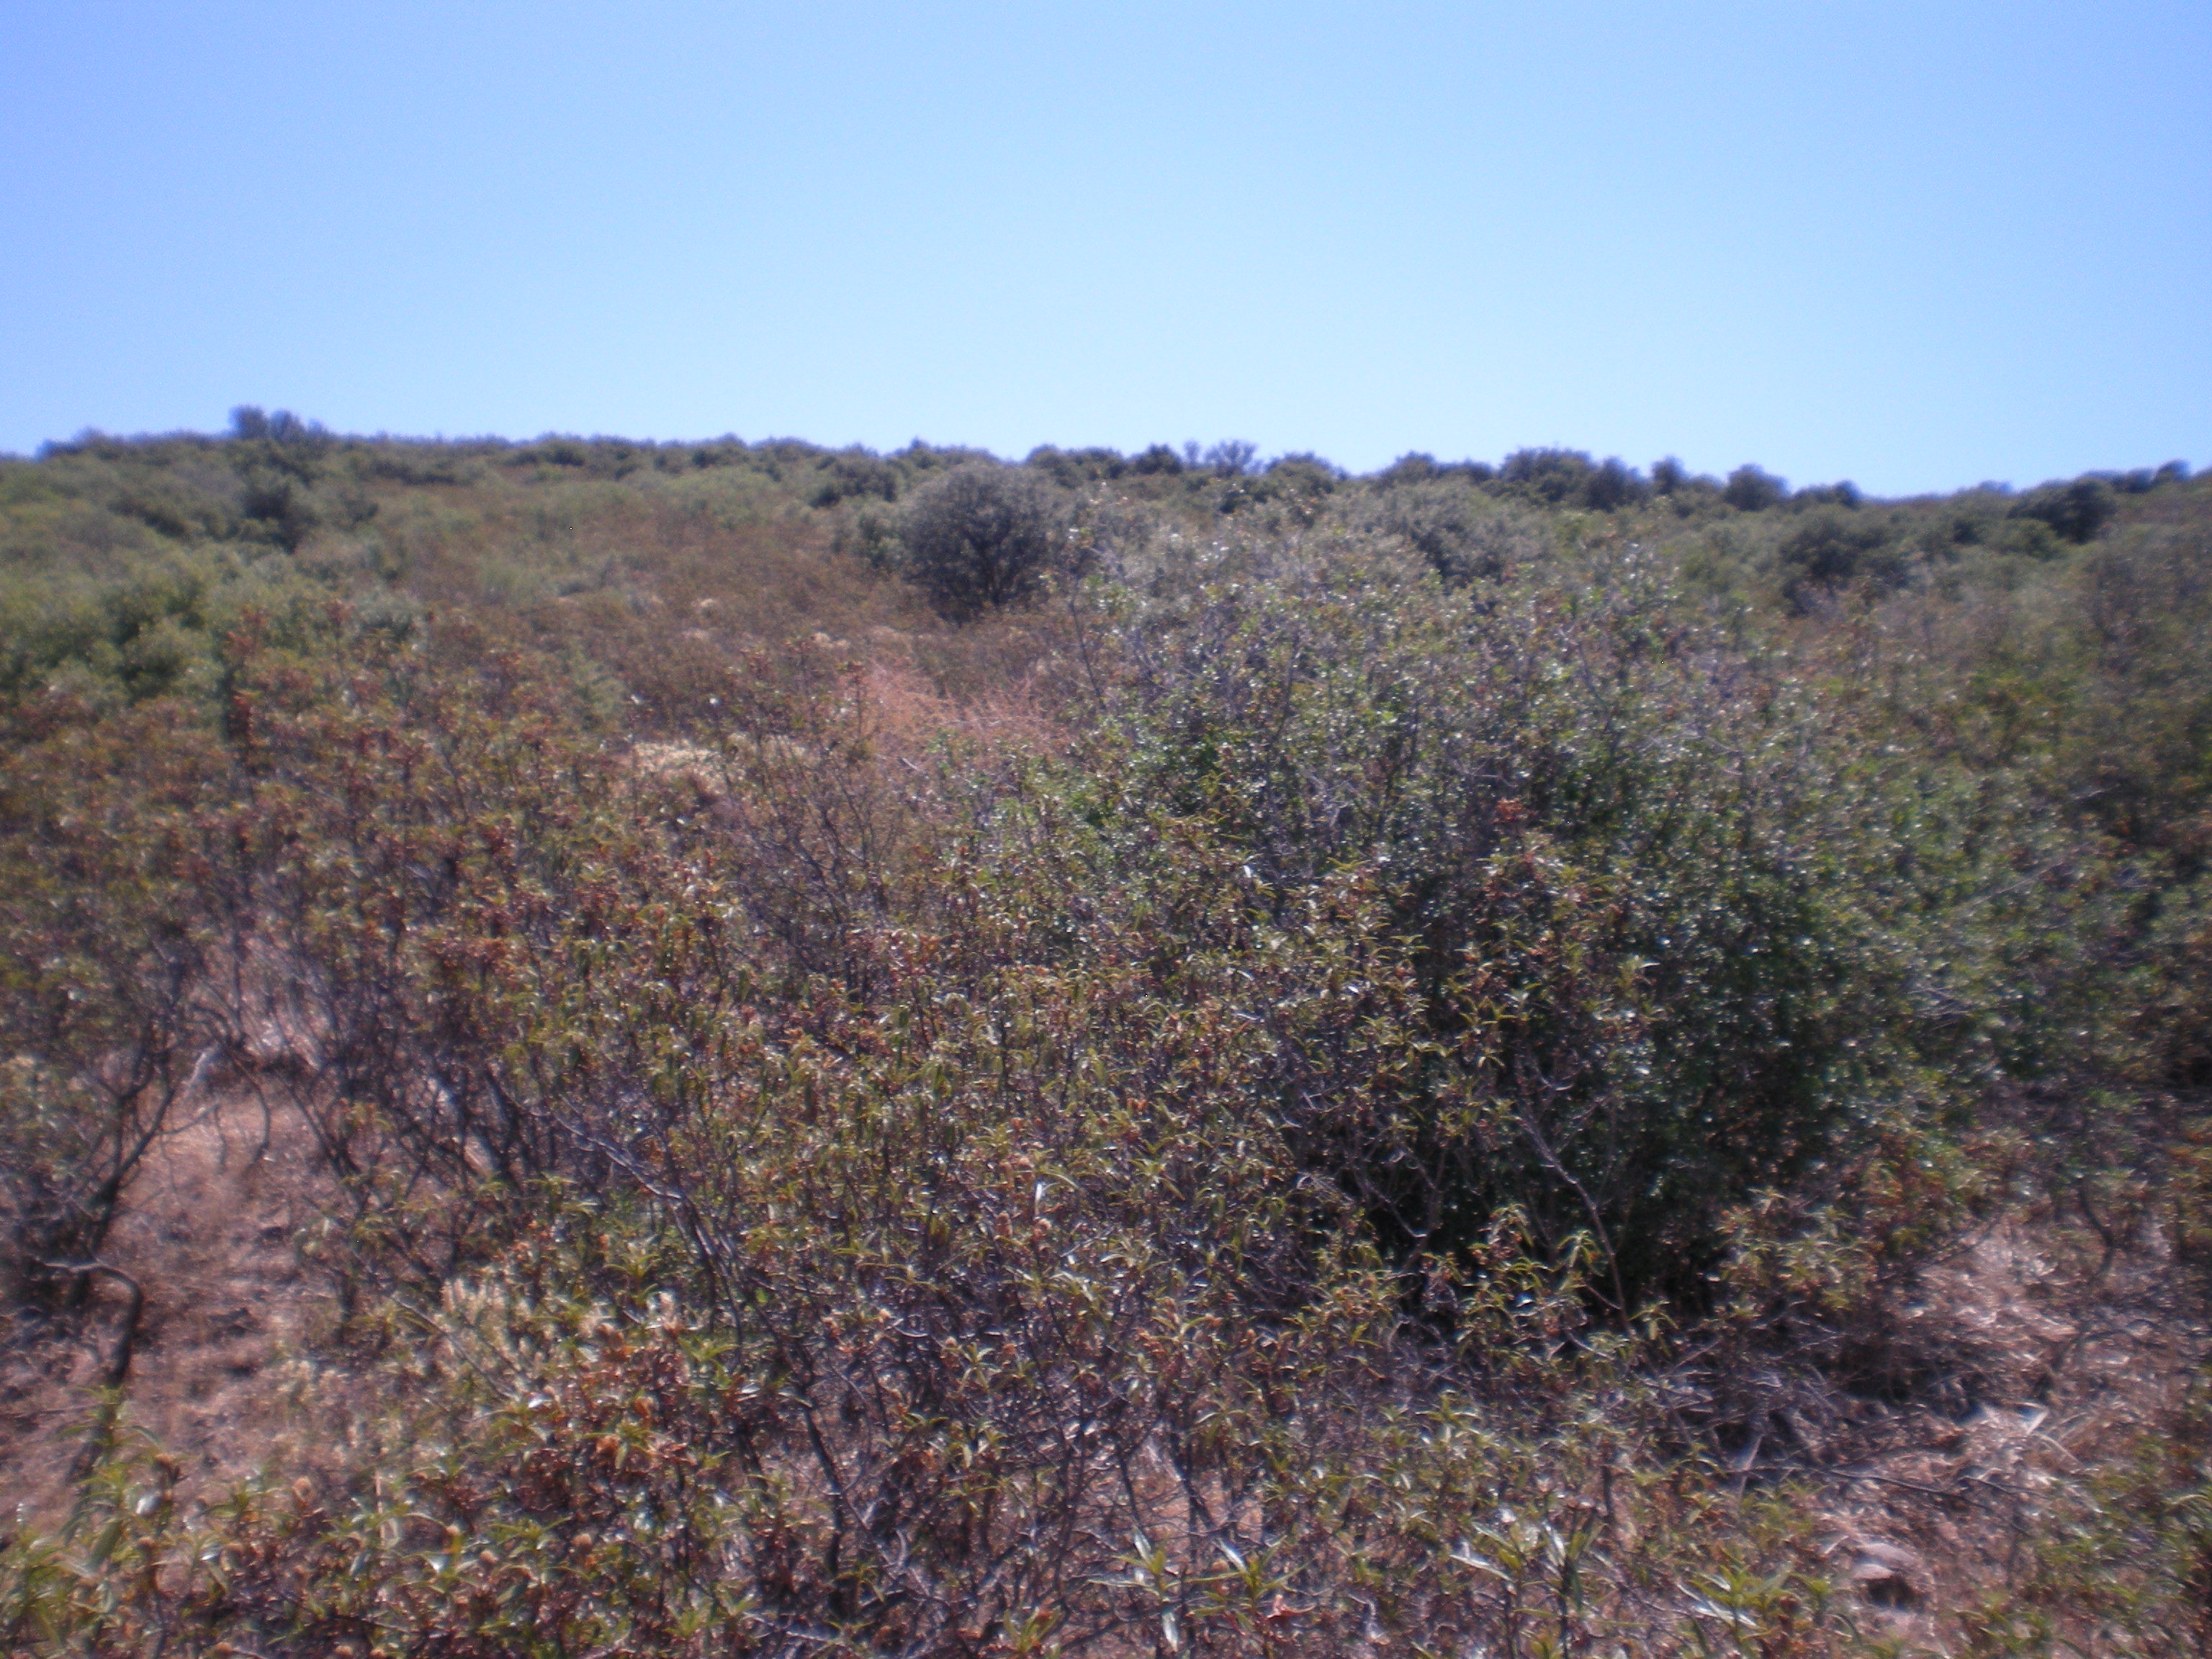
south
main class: Shrubland
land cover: Shrubland with sparse tree cover
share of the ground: > 75 %
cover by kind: shrubs 75 %, herbaceous plants 10 %, unconsolidated bare surface 10 %, broadleaved forest trees 5 %
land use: Semi-natural and natural areas not in use
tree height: < 5 m
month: July
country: ES
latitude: 39.3311
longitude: -3.4889
